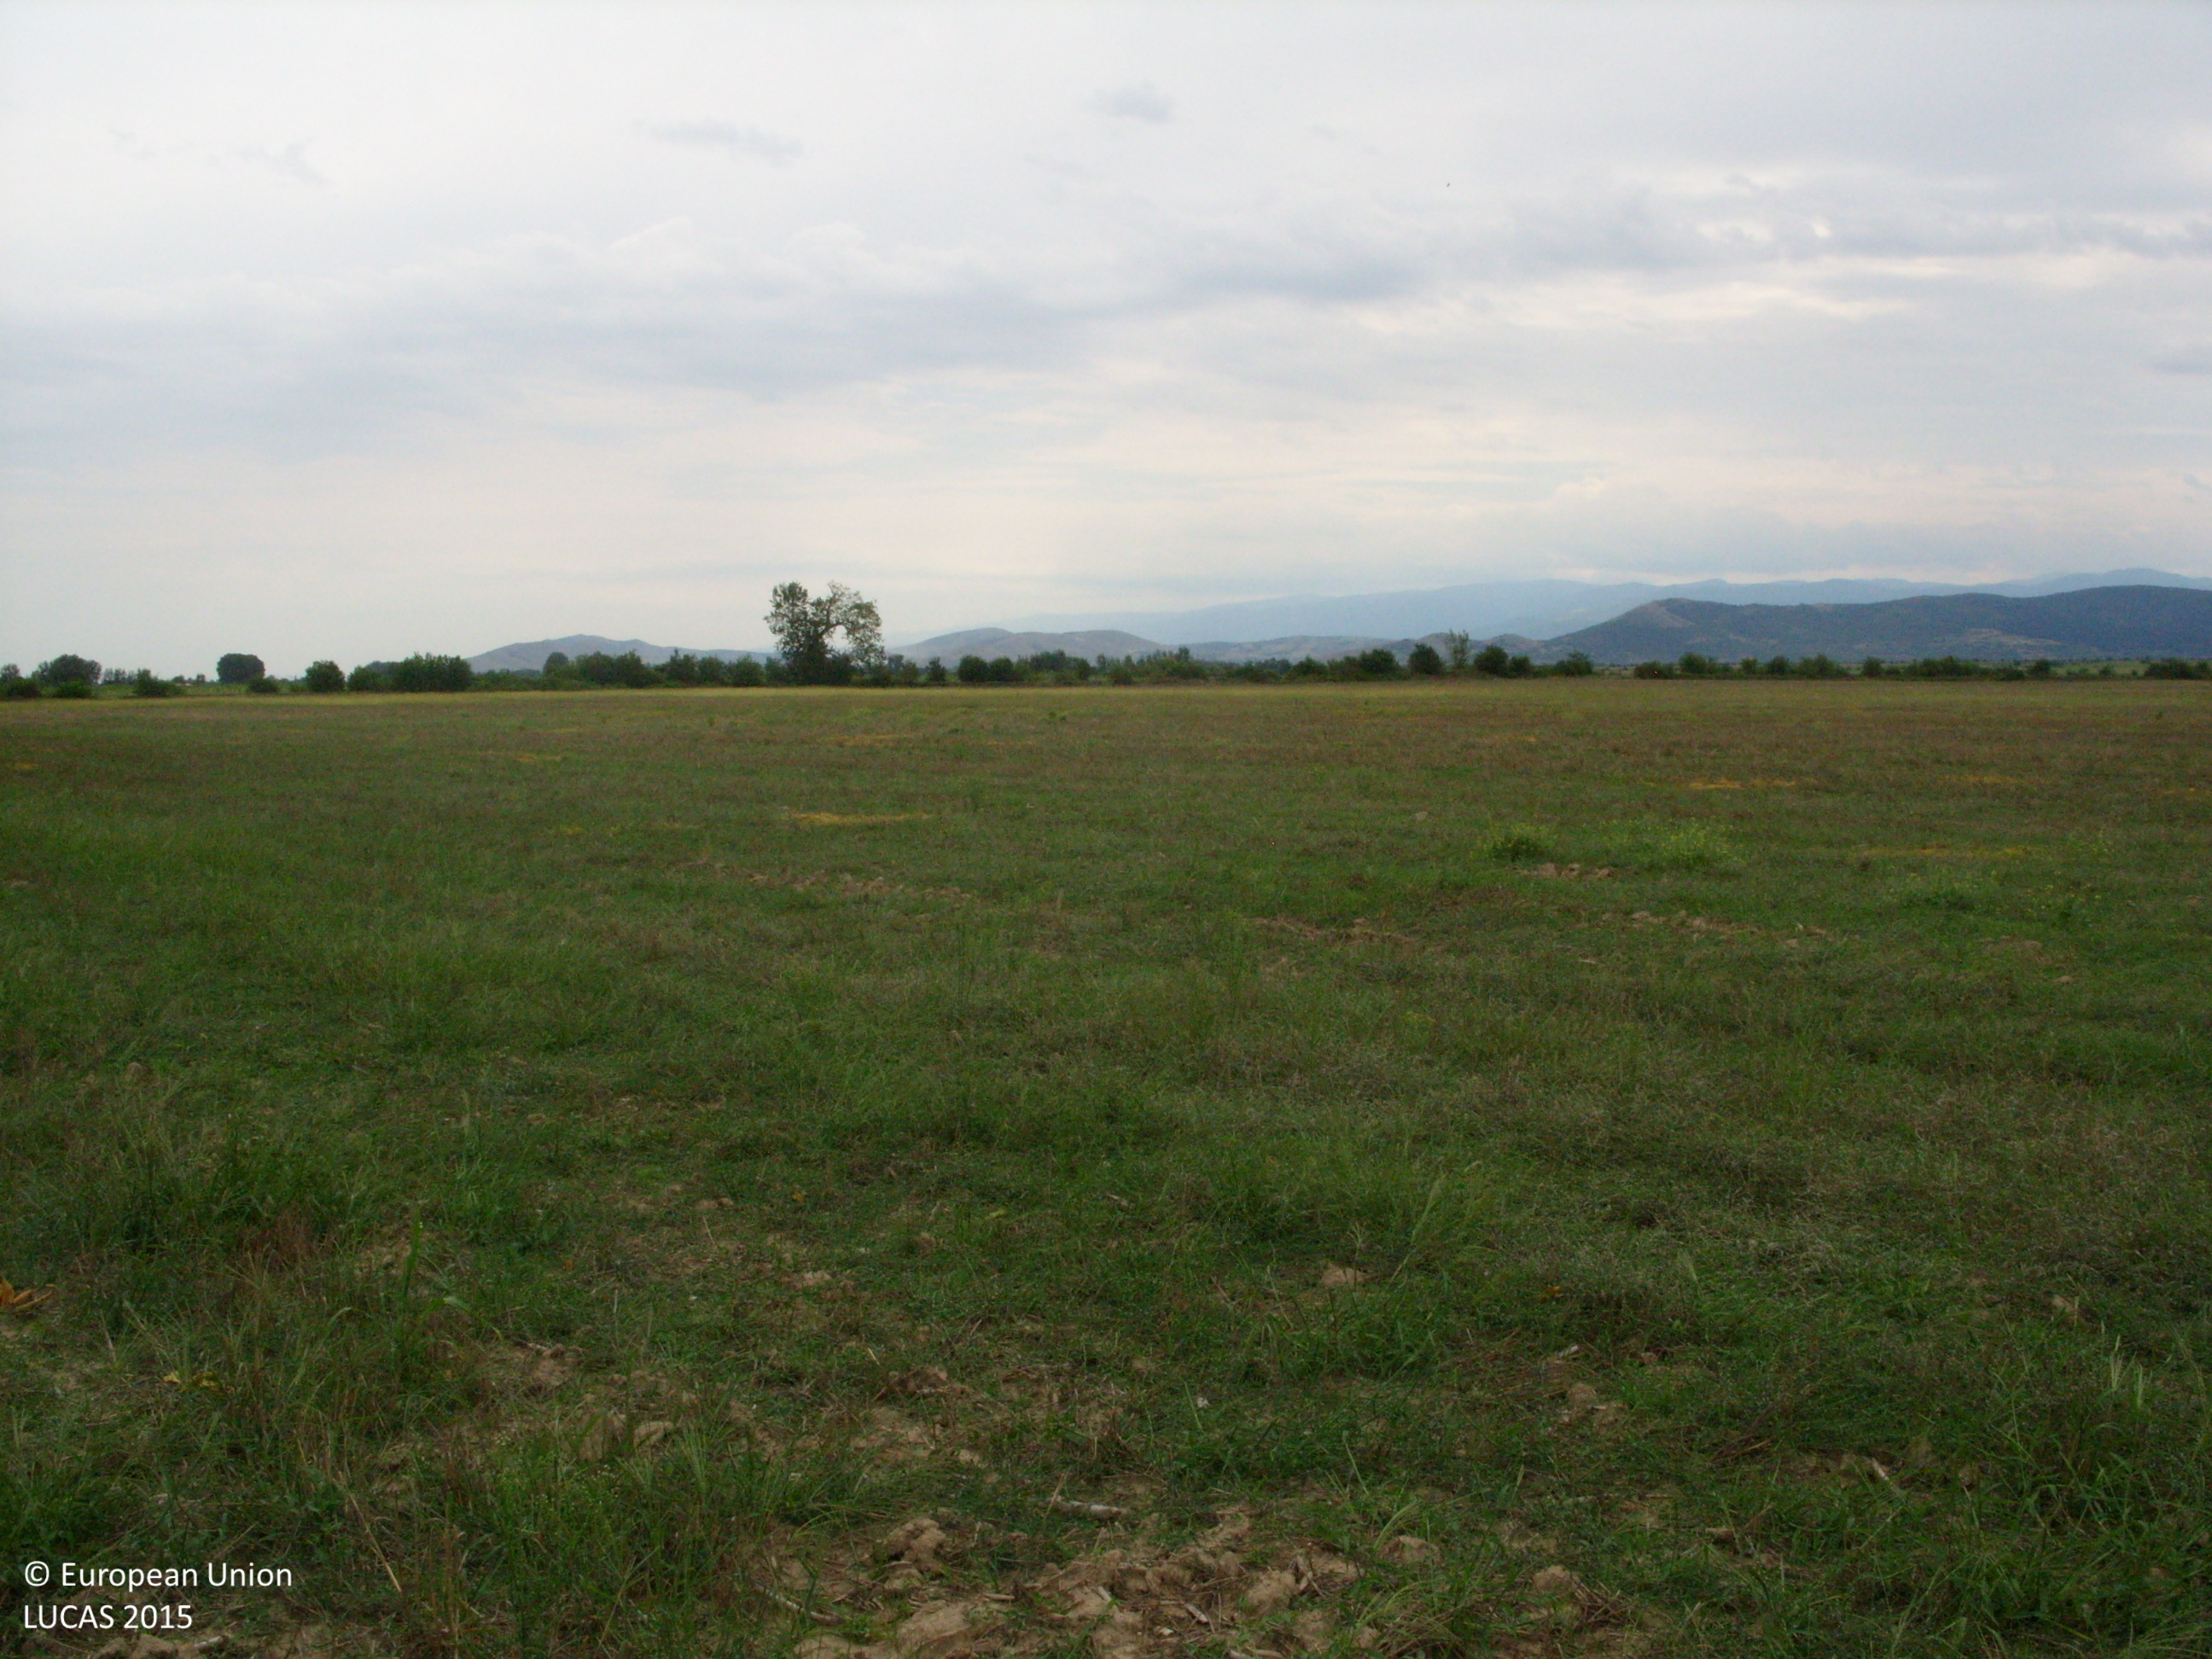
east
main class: Cropland
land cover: Common wheat
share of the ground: < 10 %
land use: Agriculture (excluding fallow land and kitchen gardens)
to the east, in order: Common wheat
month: September
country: BG
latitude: 42.1617
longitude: 24.1910
